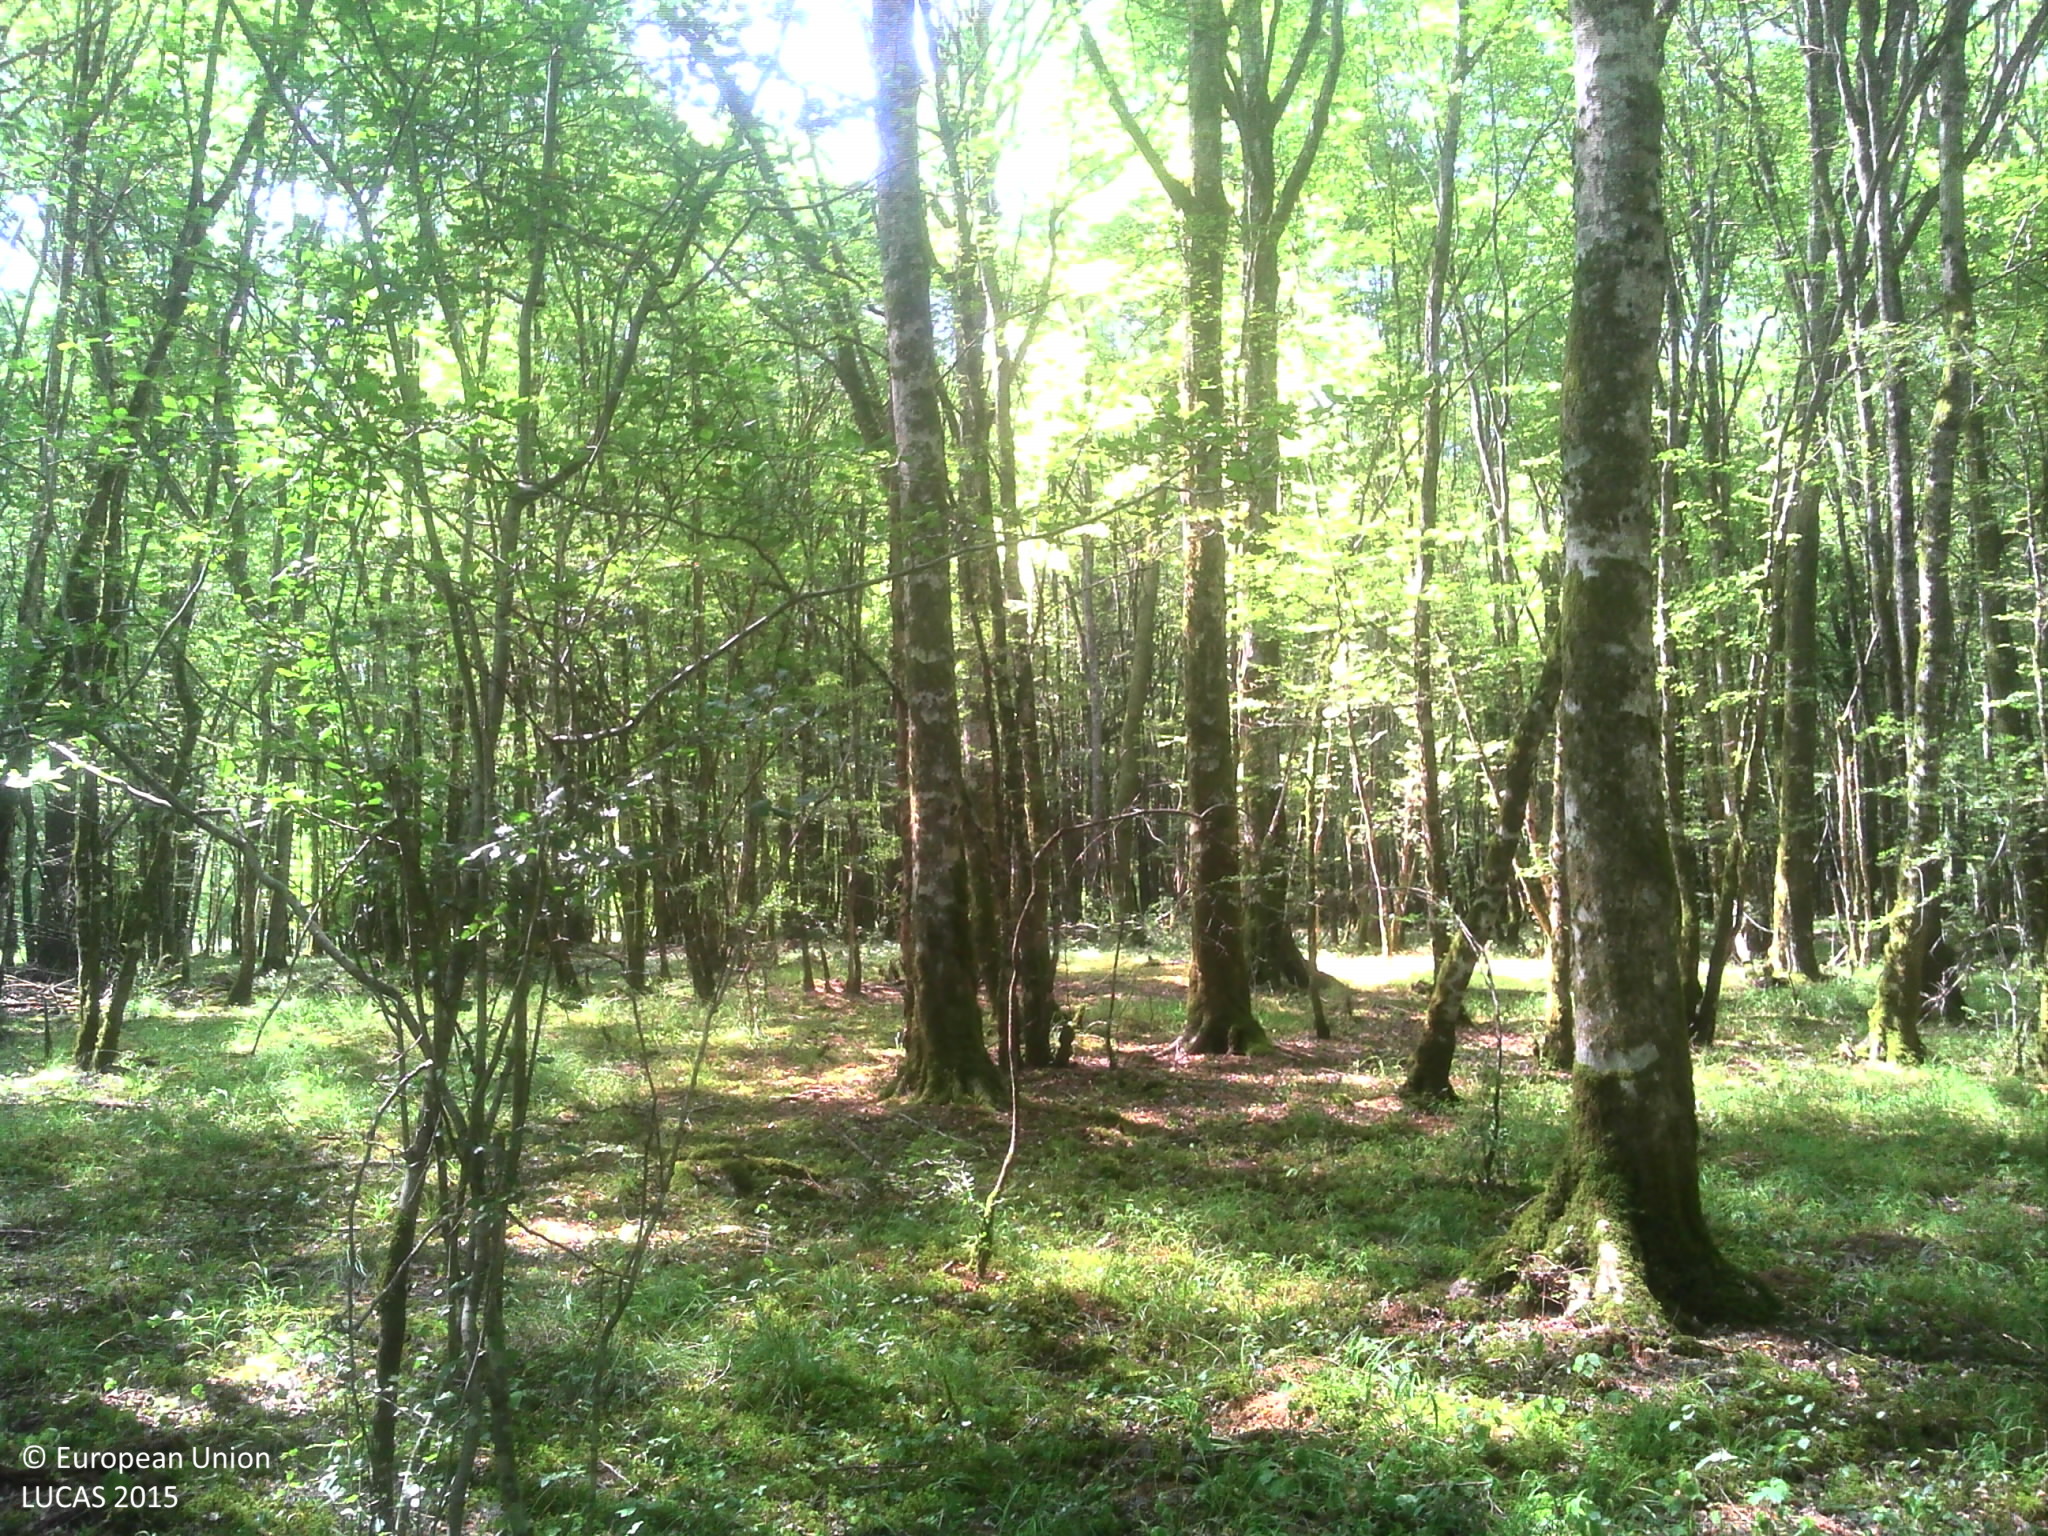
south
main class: Woodland
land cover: Broadleaved woodland
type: beech forest
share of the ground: > 75 %
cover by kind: broadleaved forest trees 80 %, herbaceous plants 10 %, lichens and mosses 10 %
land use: Forestry
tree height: > 5 m
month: July
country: FR
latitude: 48.0174
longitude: 4.9445
